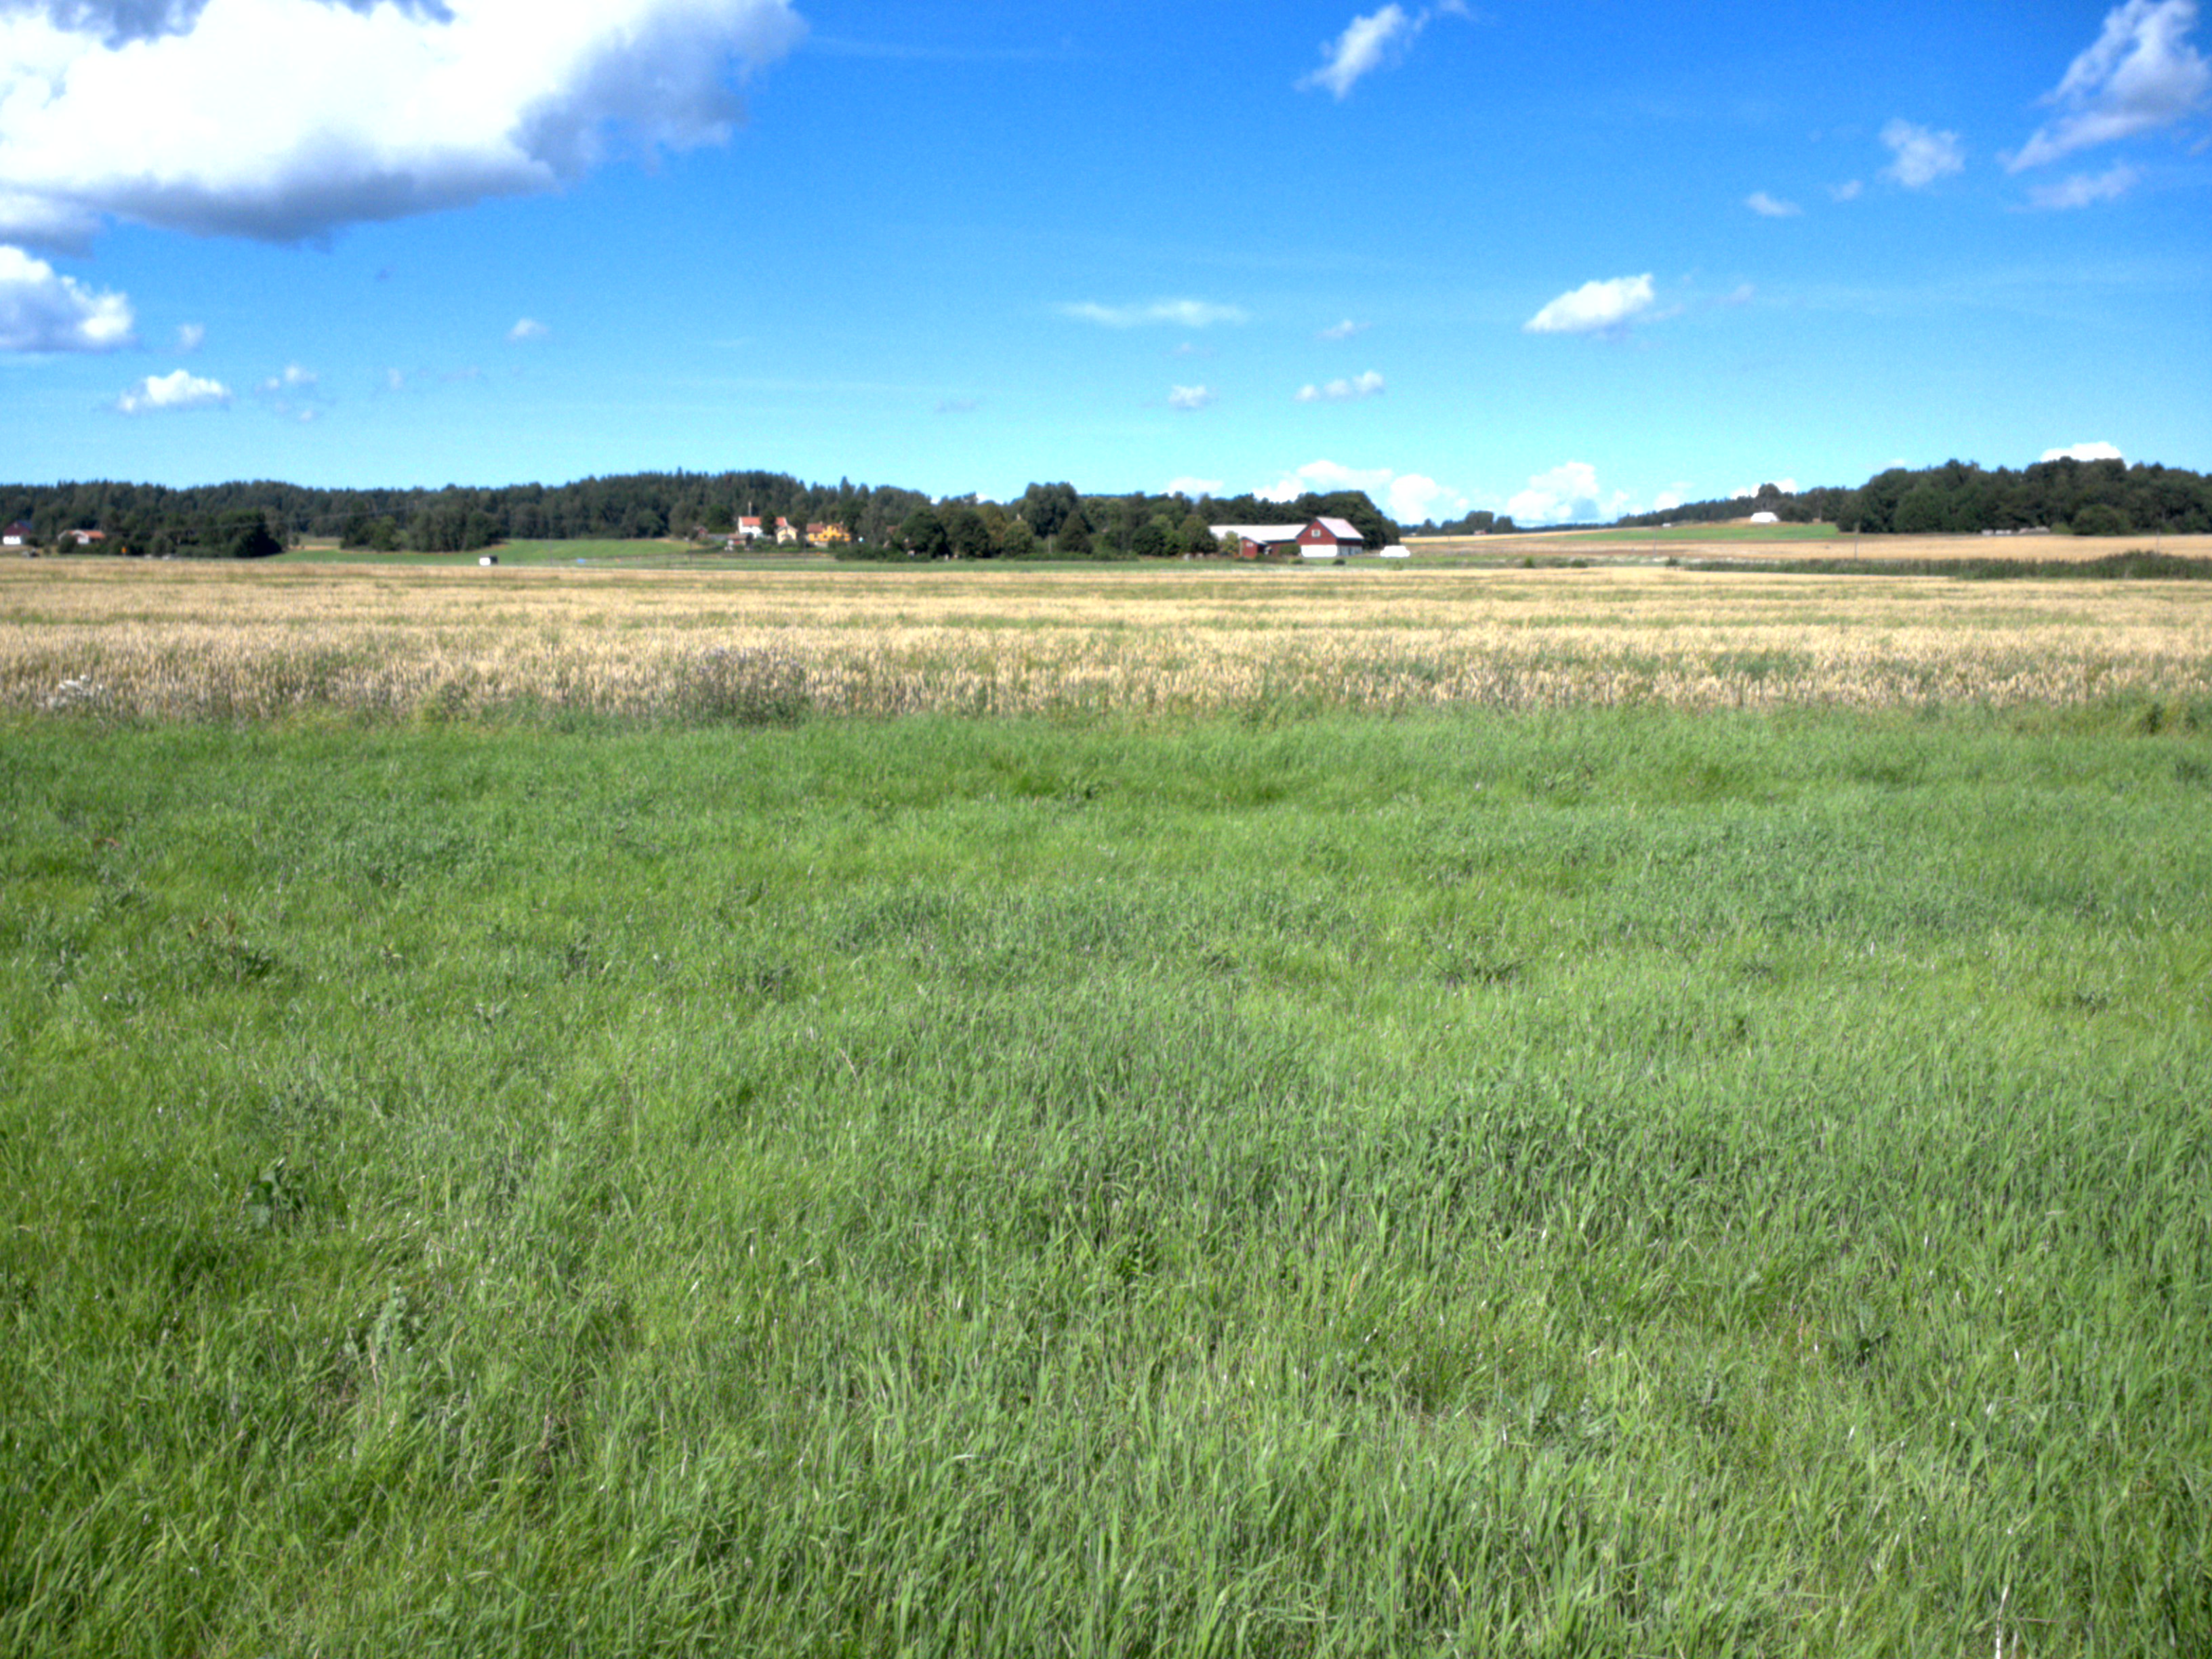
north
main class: Cropland
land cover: Temporary grasslands
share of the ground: > 75 %
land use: Agriculture (excluding fallow land and kitchen gardens)
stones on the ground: < 10 %
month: August
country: SE
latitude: 59.0999
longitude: 17.7320
